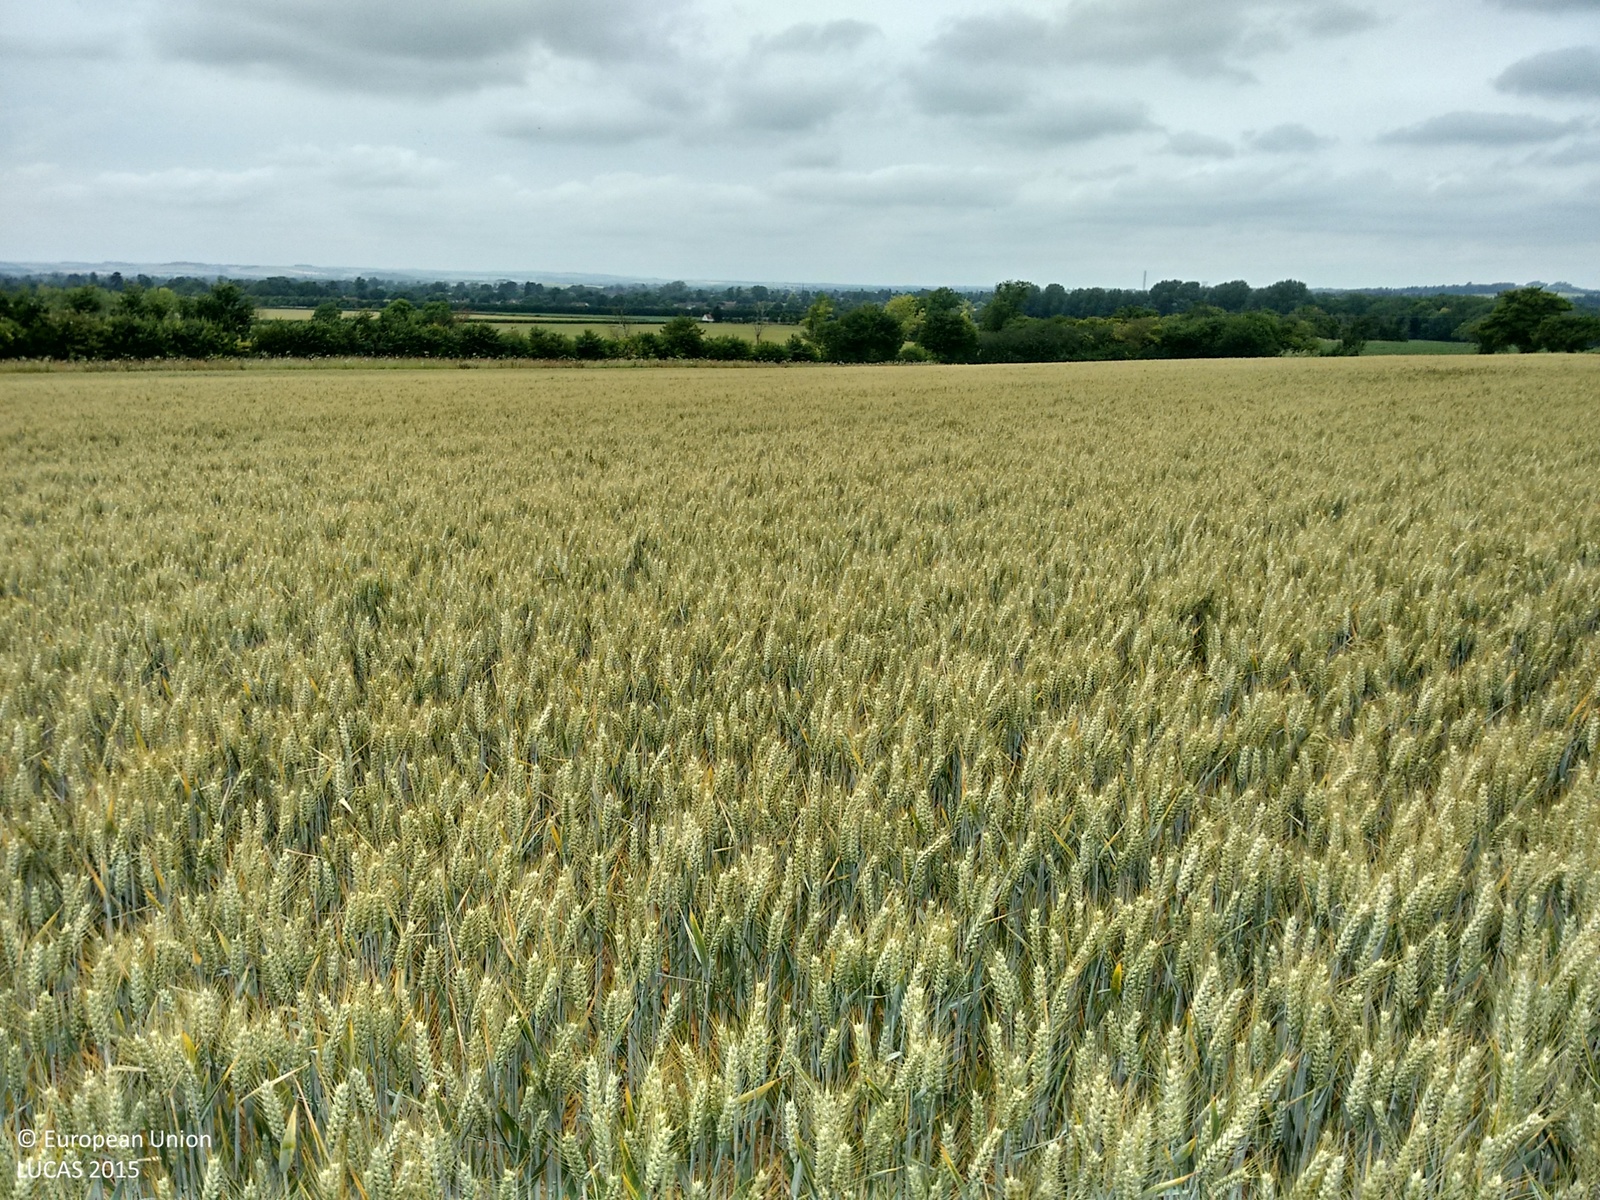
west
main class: Cropland
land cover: Common wheat
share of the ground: > 75 %
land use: Agriculture (excluding fallow land and kitchen gardens)
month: July
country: GB
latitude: 51.6019
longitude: -1.0906
